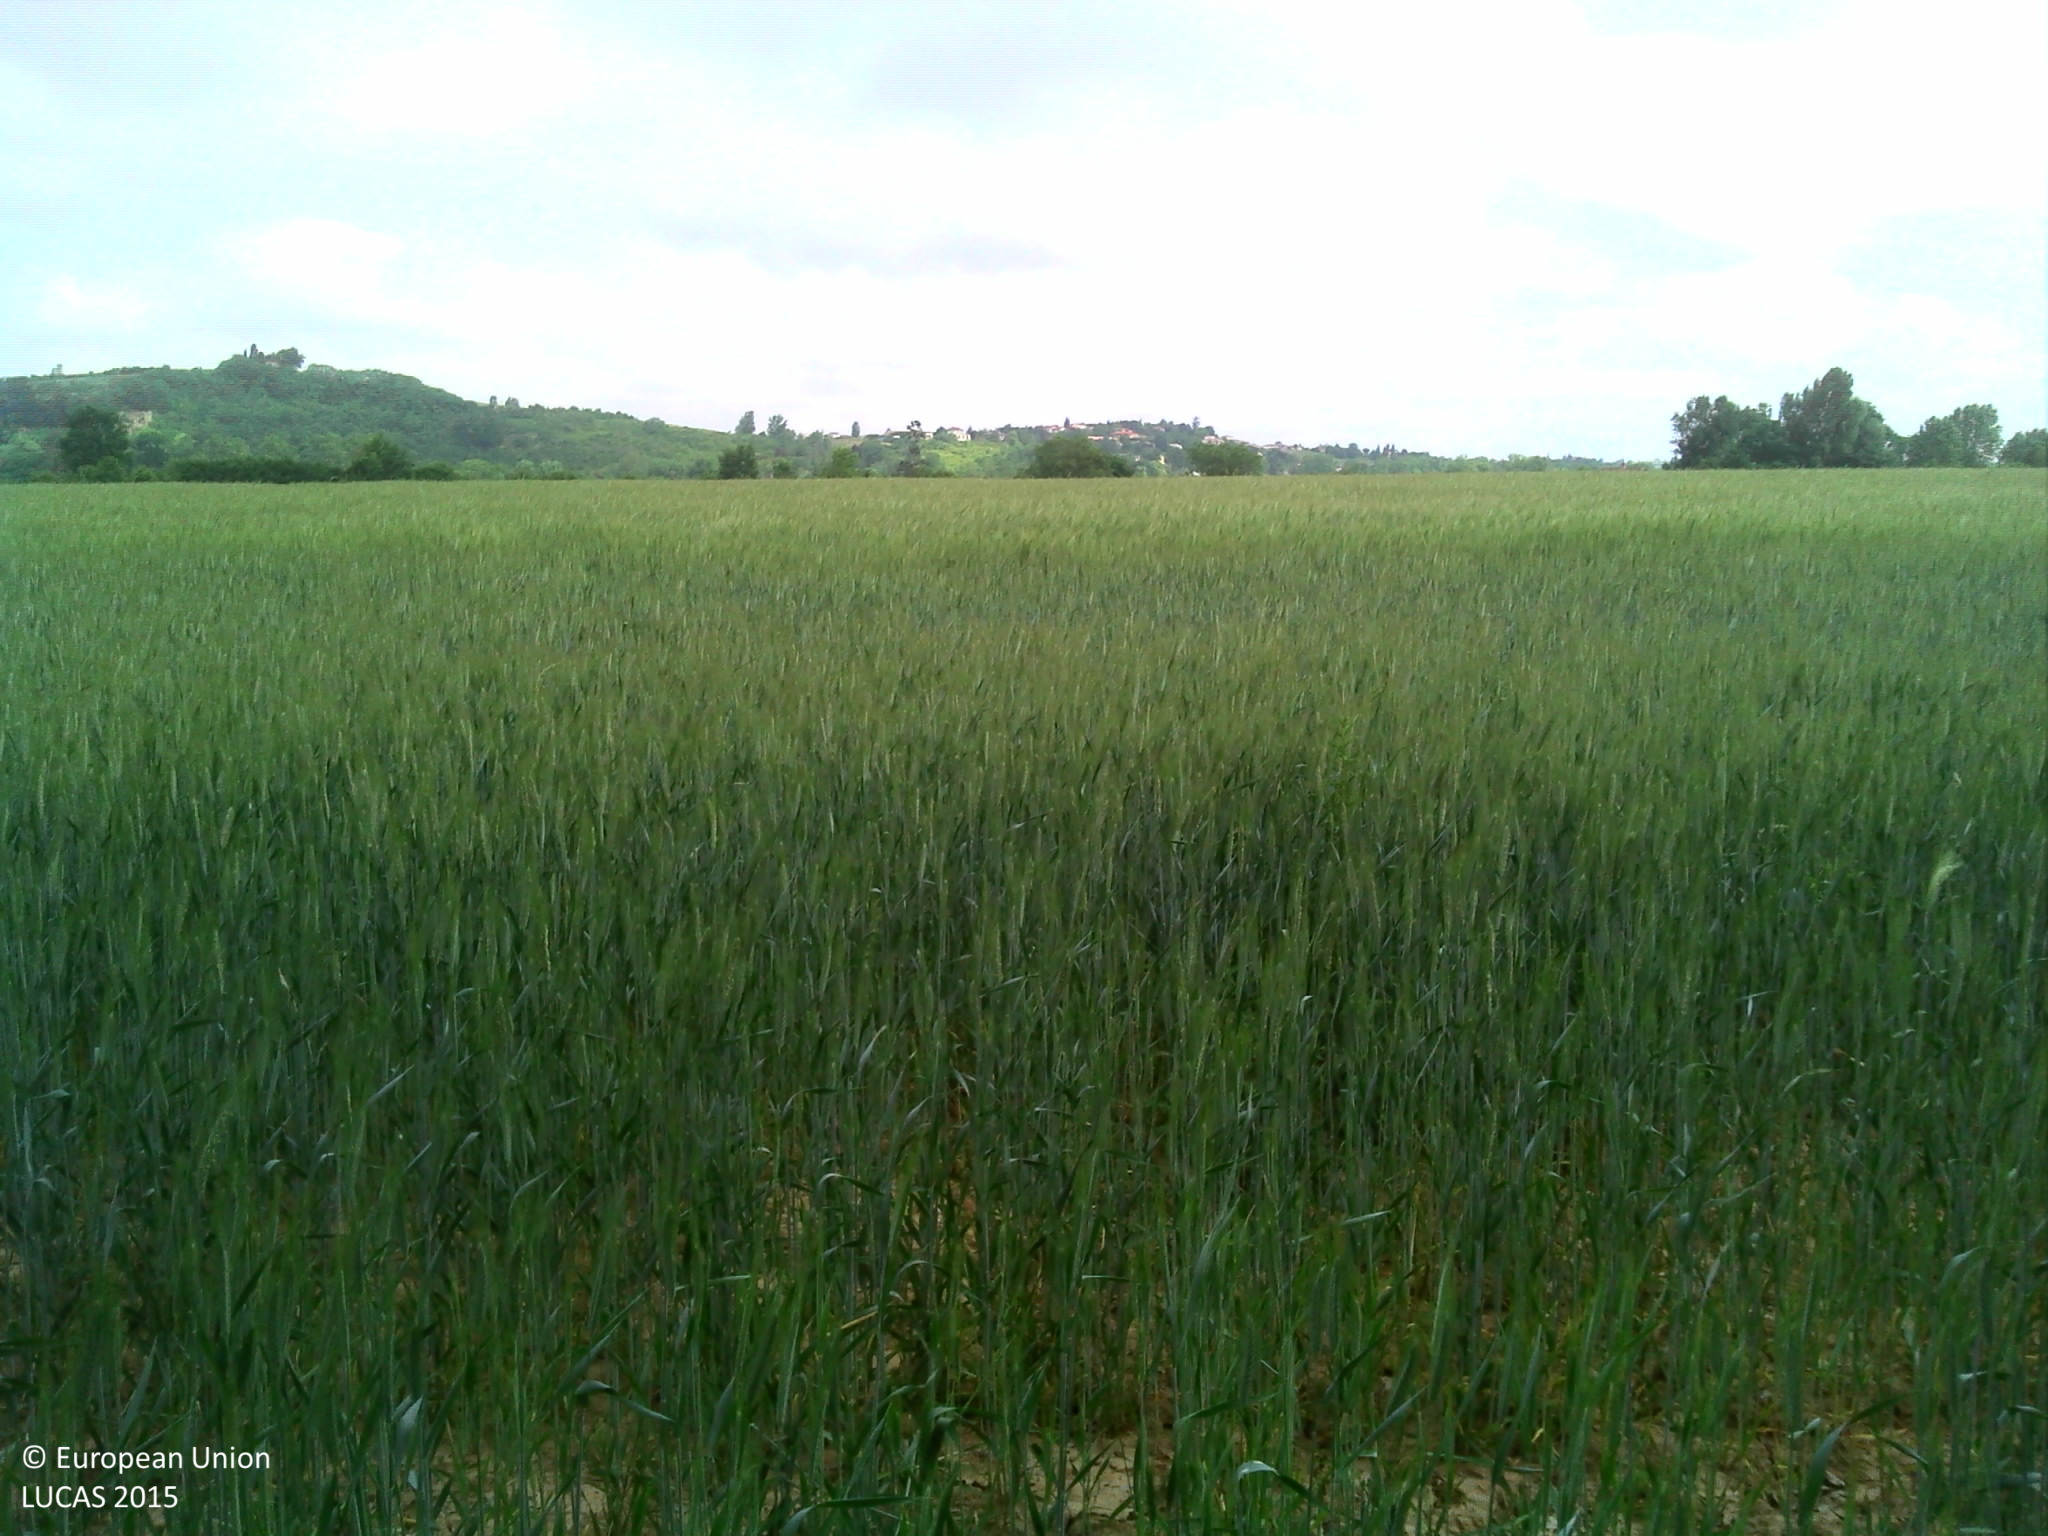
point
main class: Cropland
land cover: Triticale
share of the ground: > 75 %
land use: Agriculture (excluding fallow land and kitchen gardens)
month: May
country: FR
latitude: 43.8011
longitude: 1.7123
